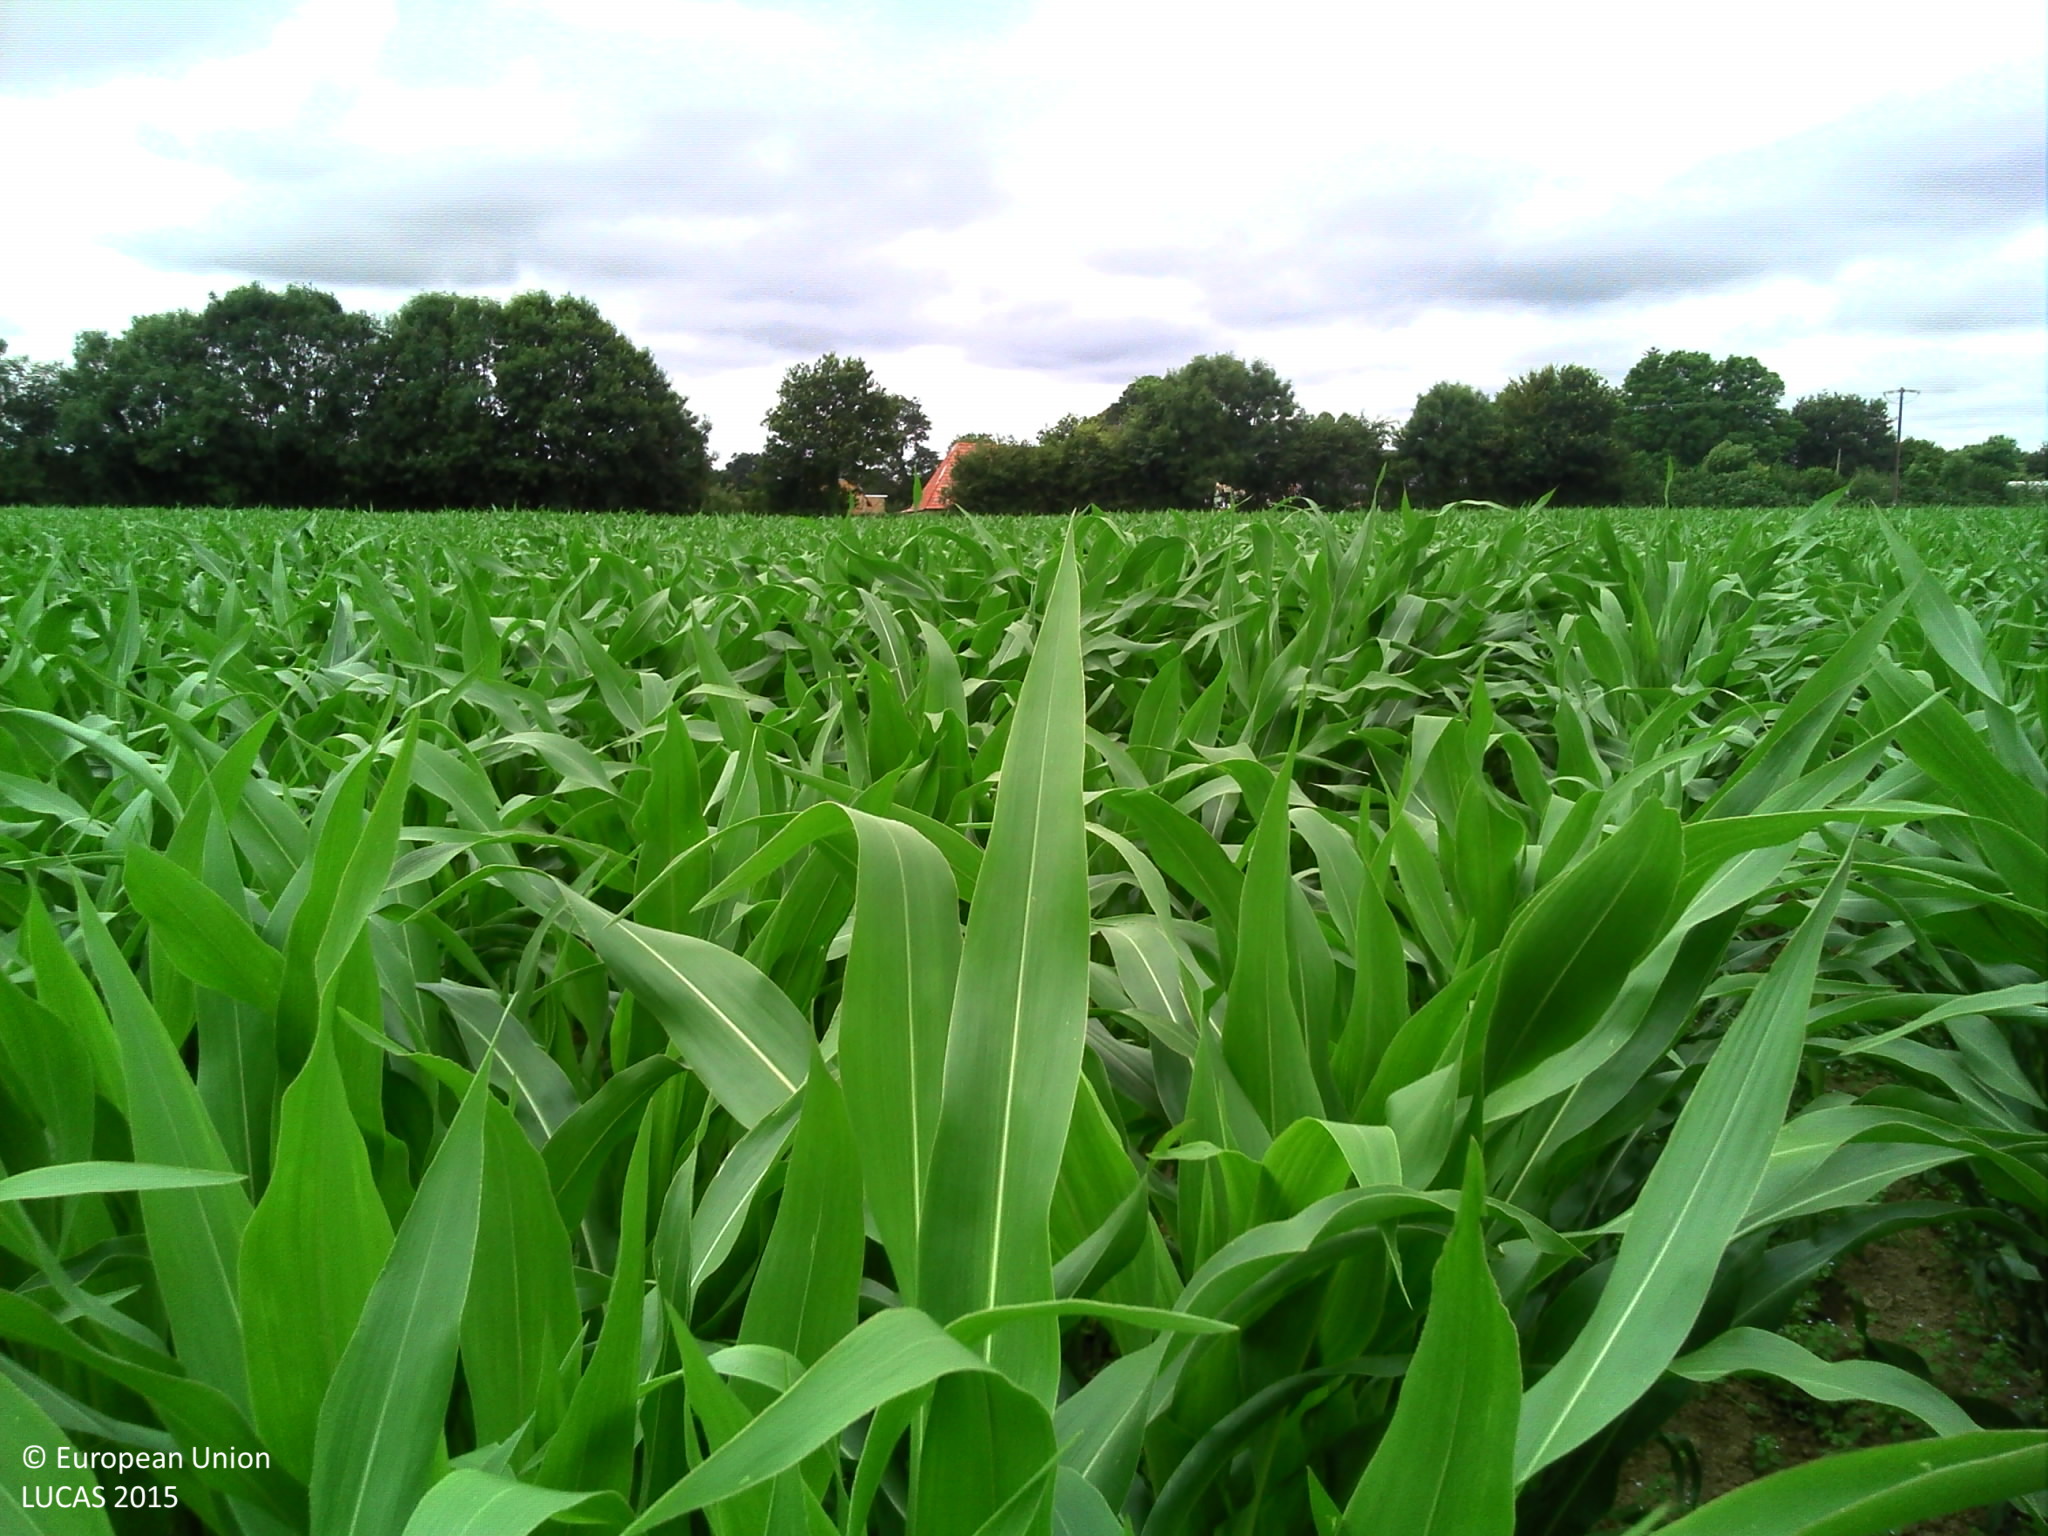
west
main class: Cropland
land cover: Maize
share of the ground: > 75 %
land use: Agriculture (excluding fallow land and kitchen gardens)
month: July
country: FR
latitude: 48.9446
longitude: -1.3377
